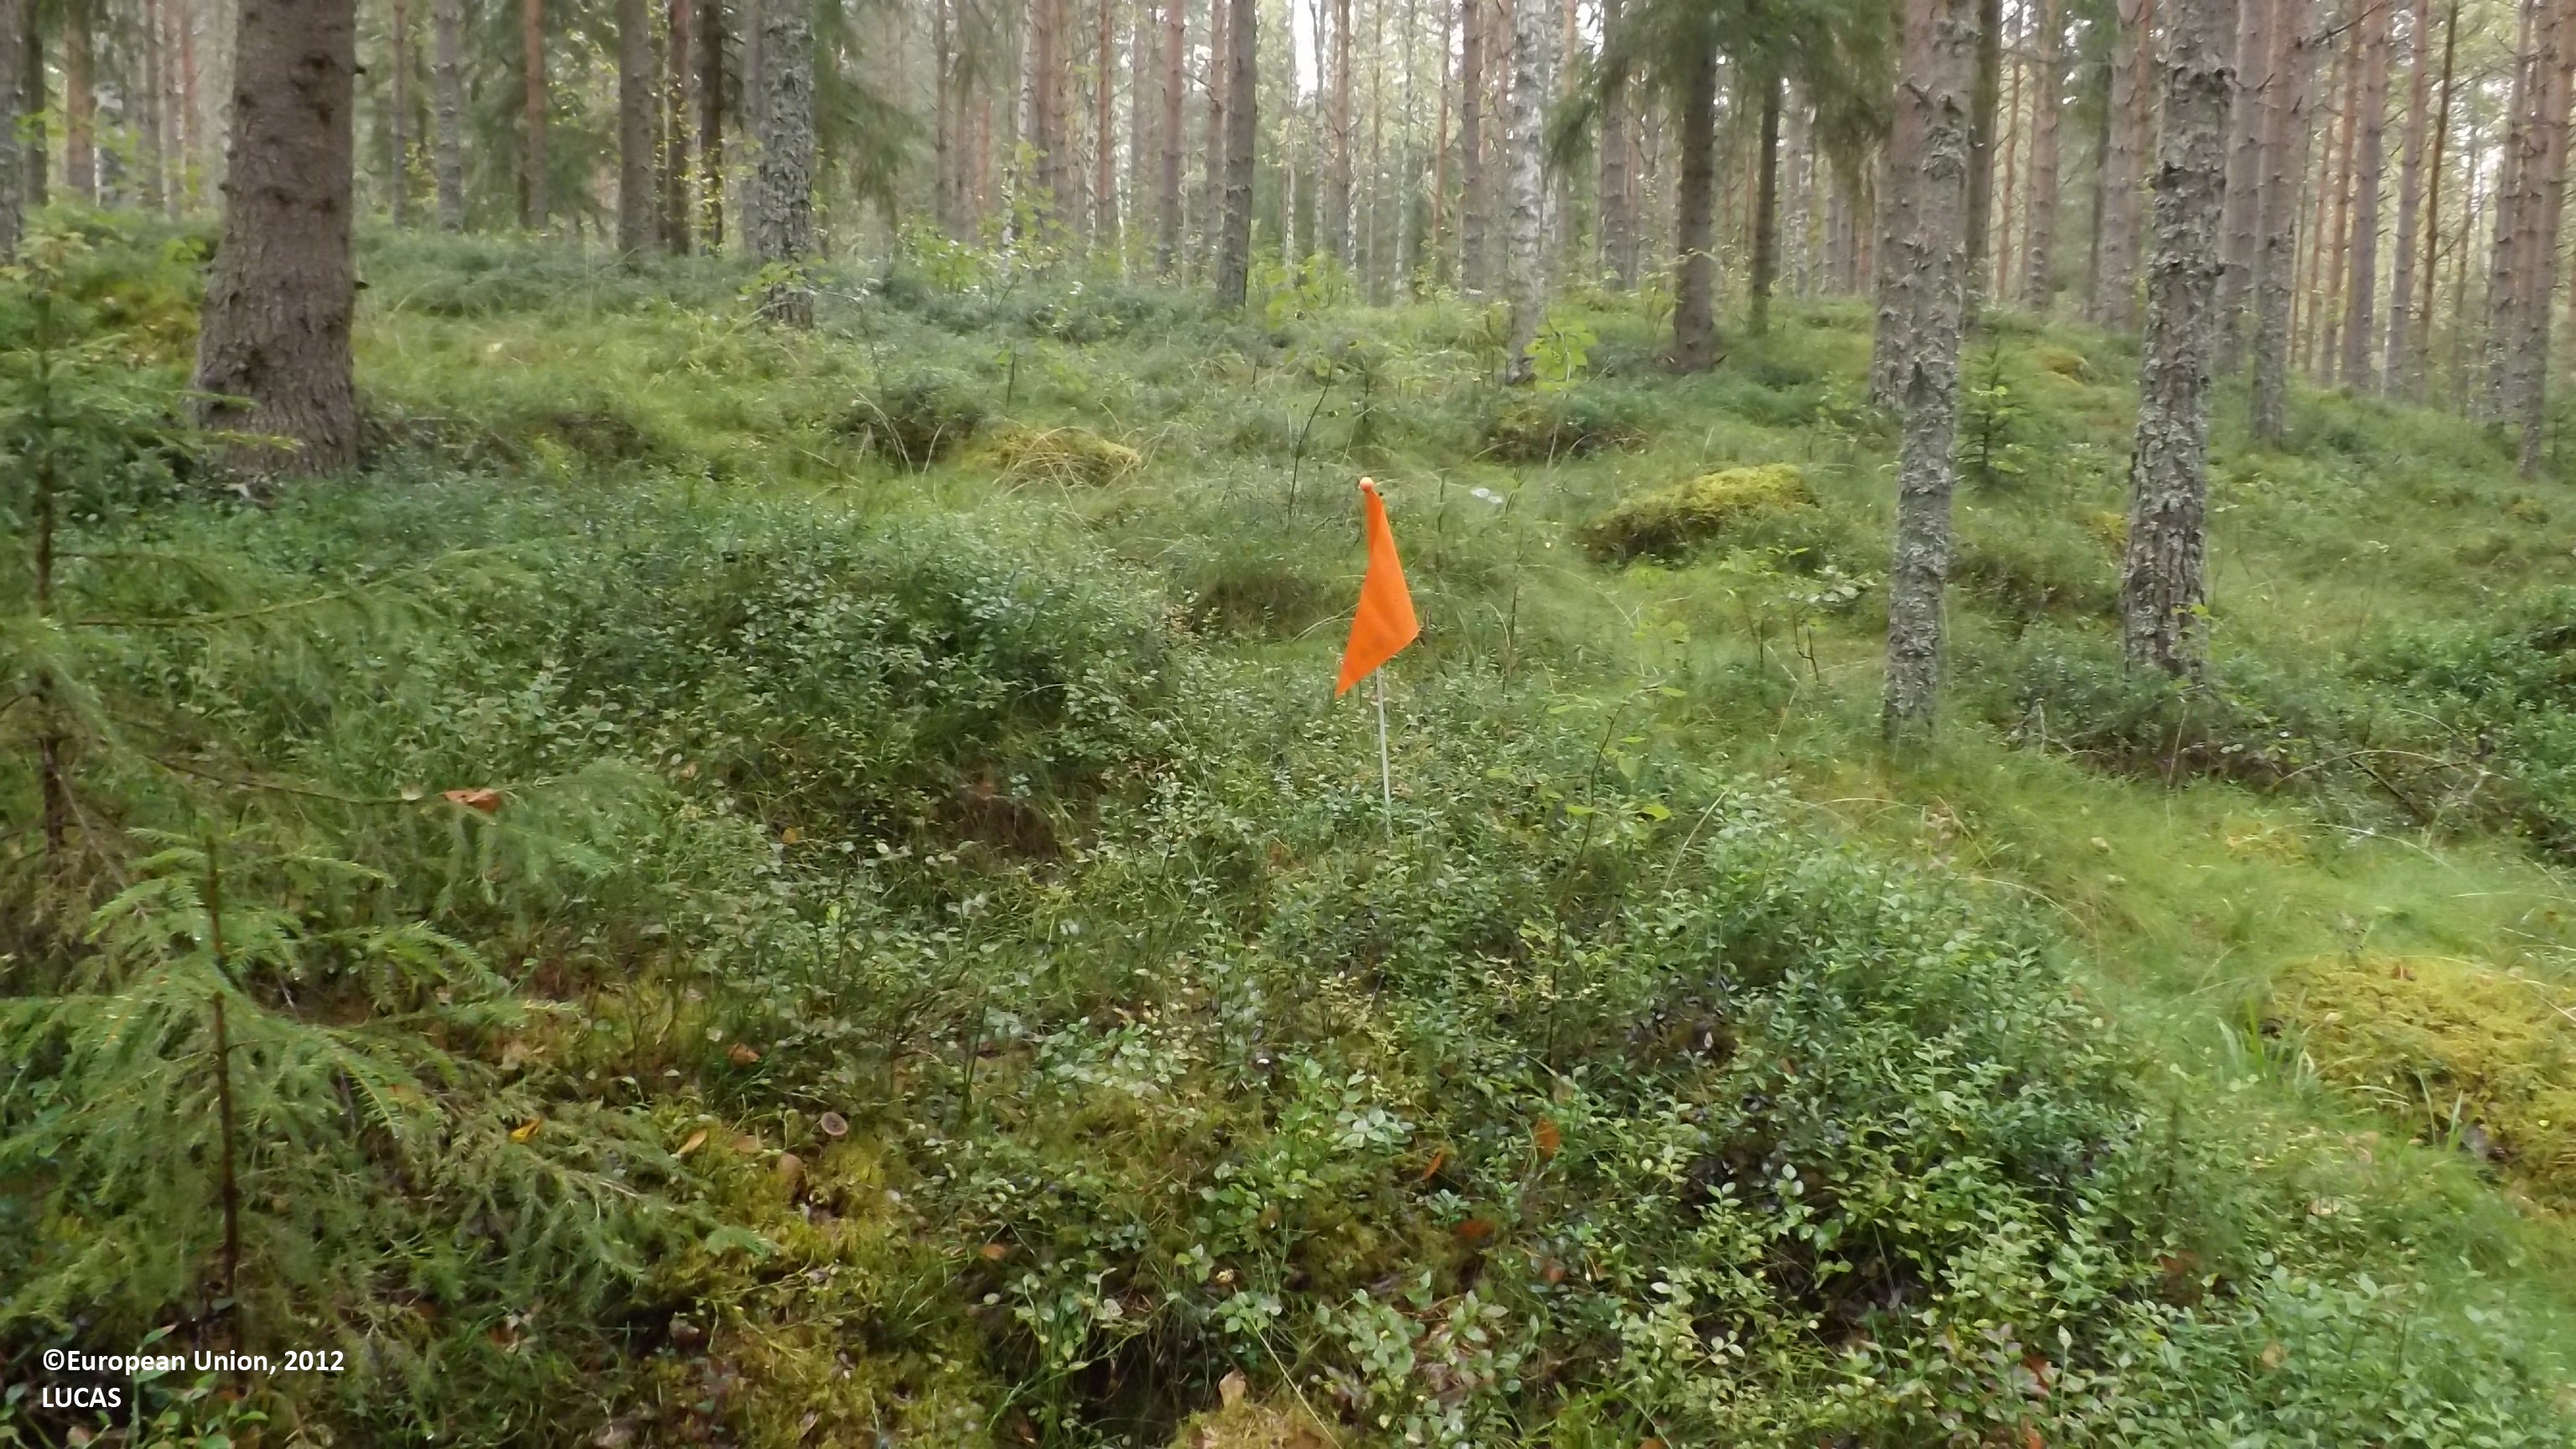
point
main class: Woodland
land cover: Other mixed woodland
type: boreal forest
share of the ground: 50 - 75 %
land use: Forestry
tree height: > 5 m
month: August
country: FI
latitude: 63.7770
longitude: 23.5492
